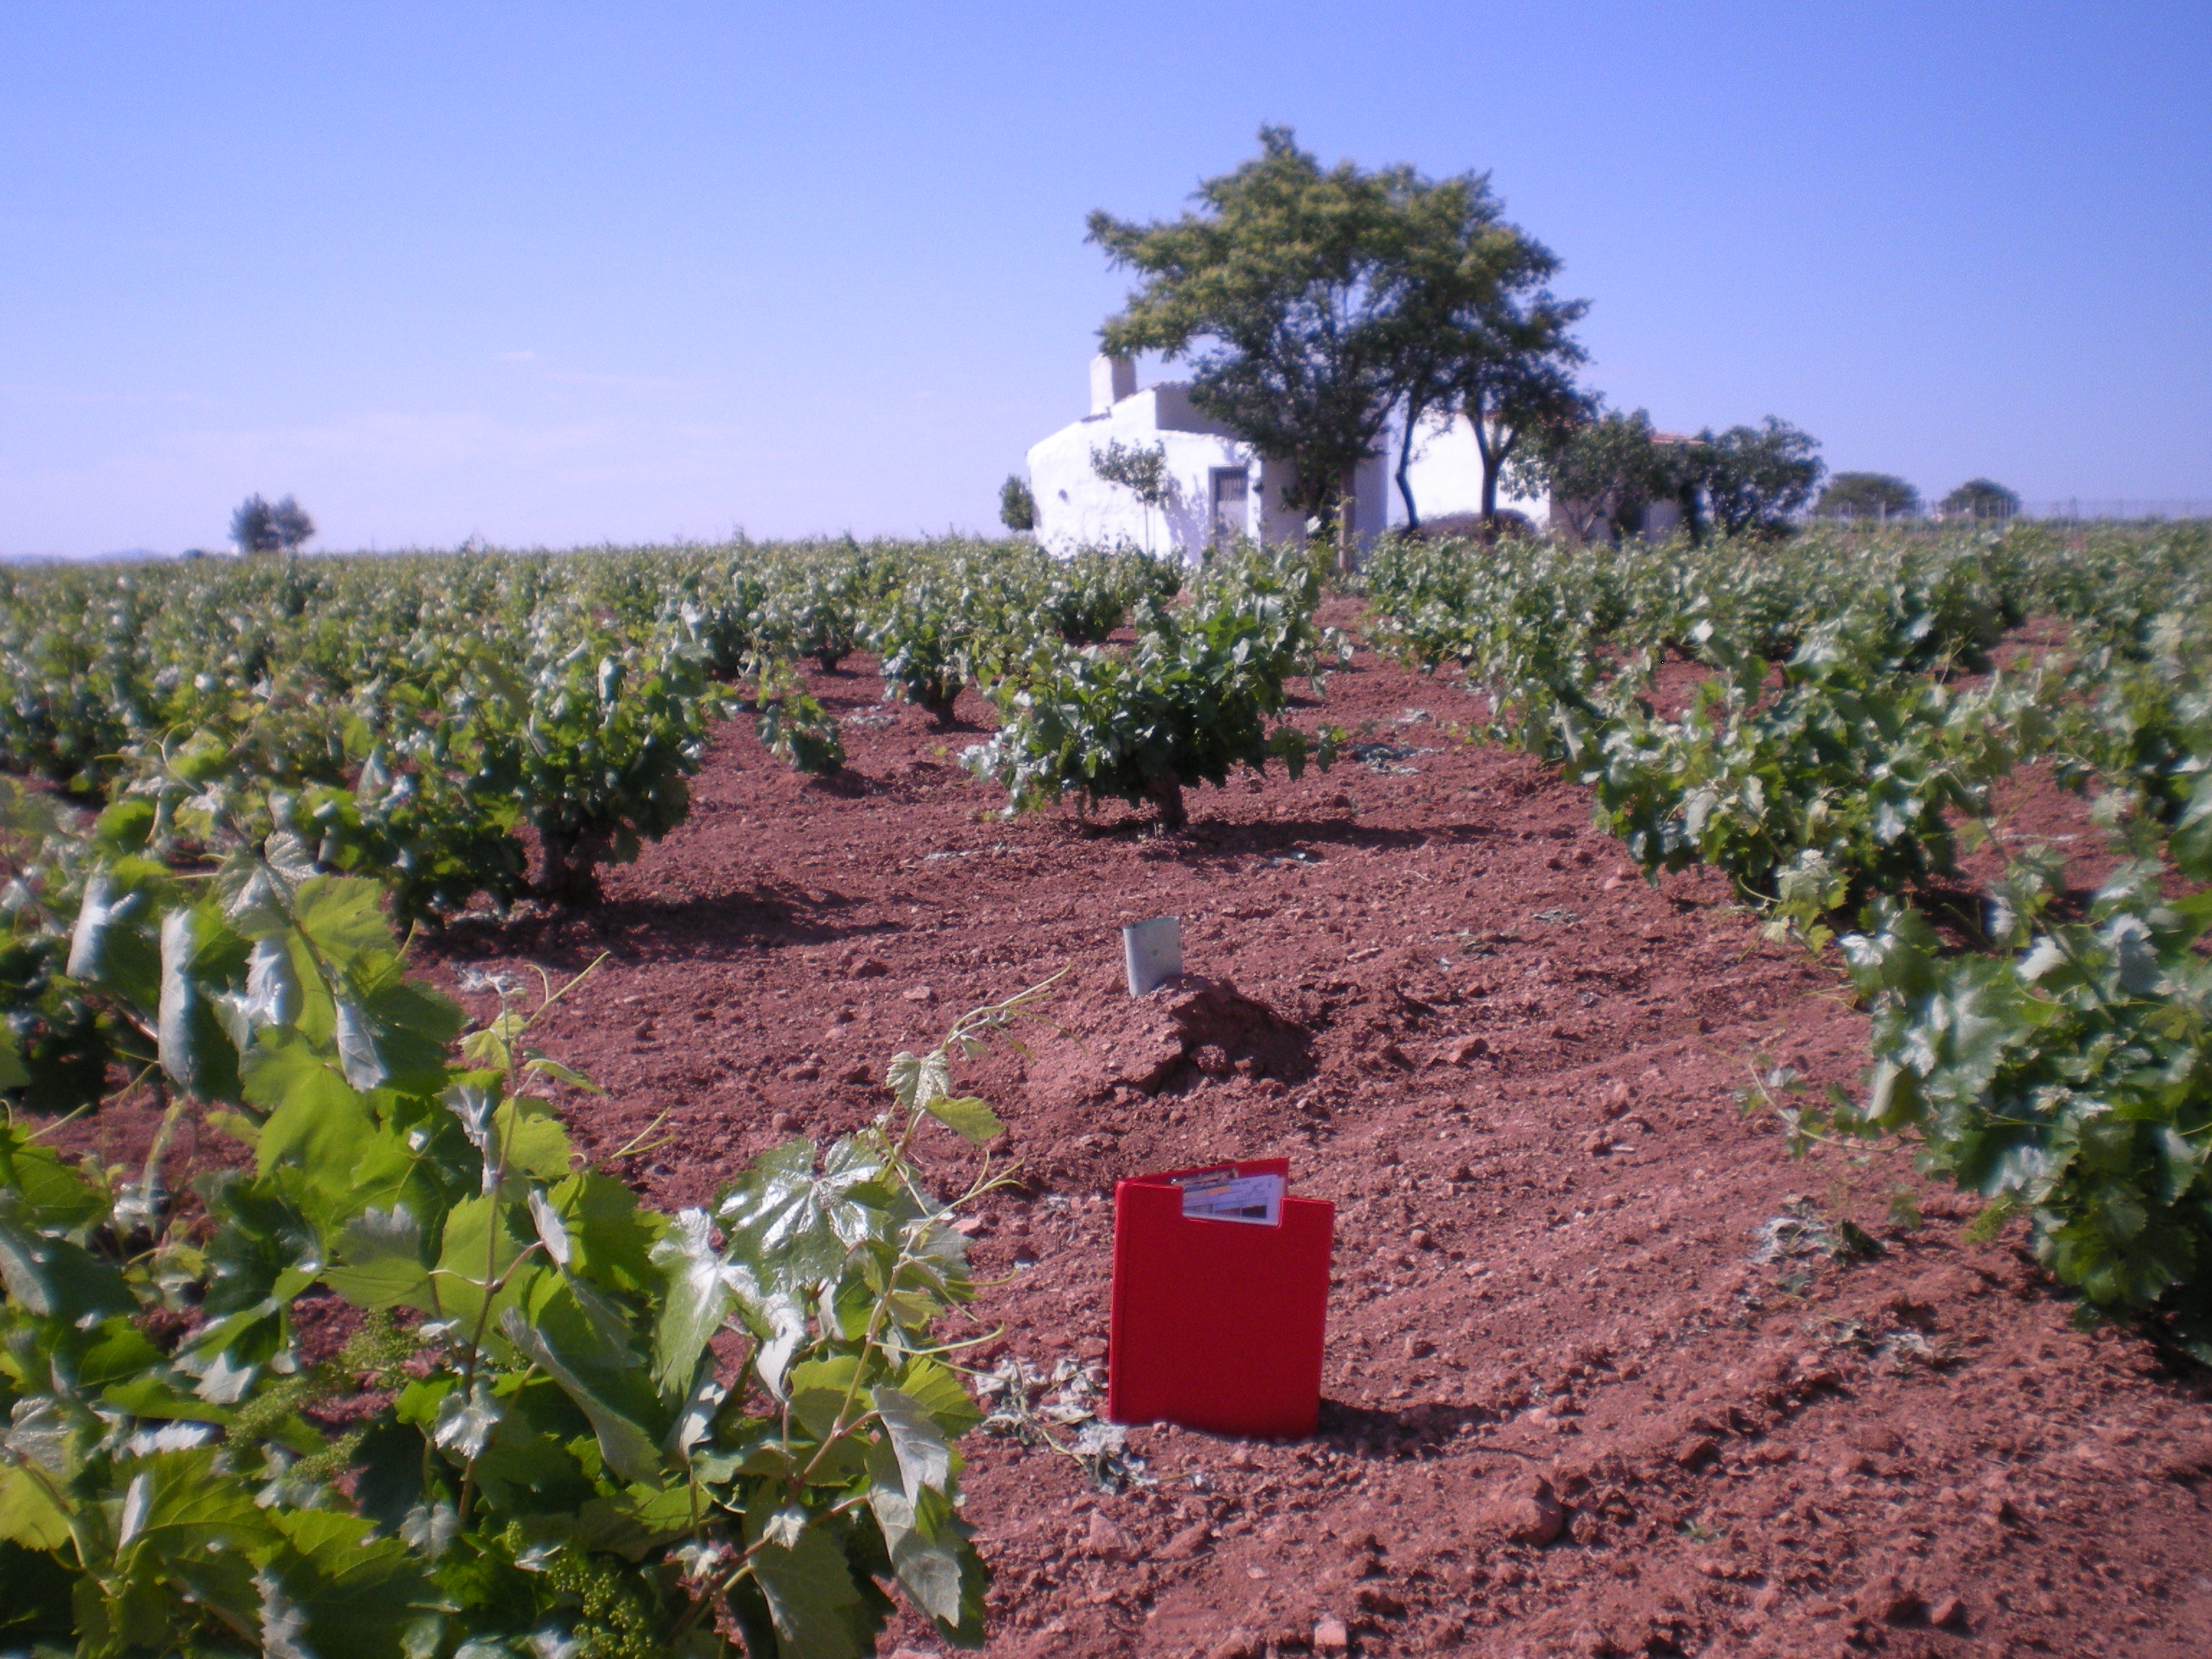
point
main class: Cropland
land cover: Vineyards
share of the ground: 10 - 25 %
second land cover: Other bare soil
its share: > 75 %
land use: Agriculture (excluding fallow land and kitchen gardens)
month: May
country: ES
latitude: 39.0462
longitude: -3.4300
